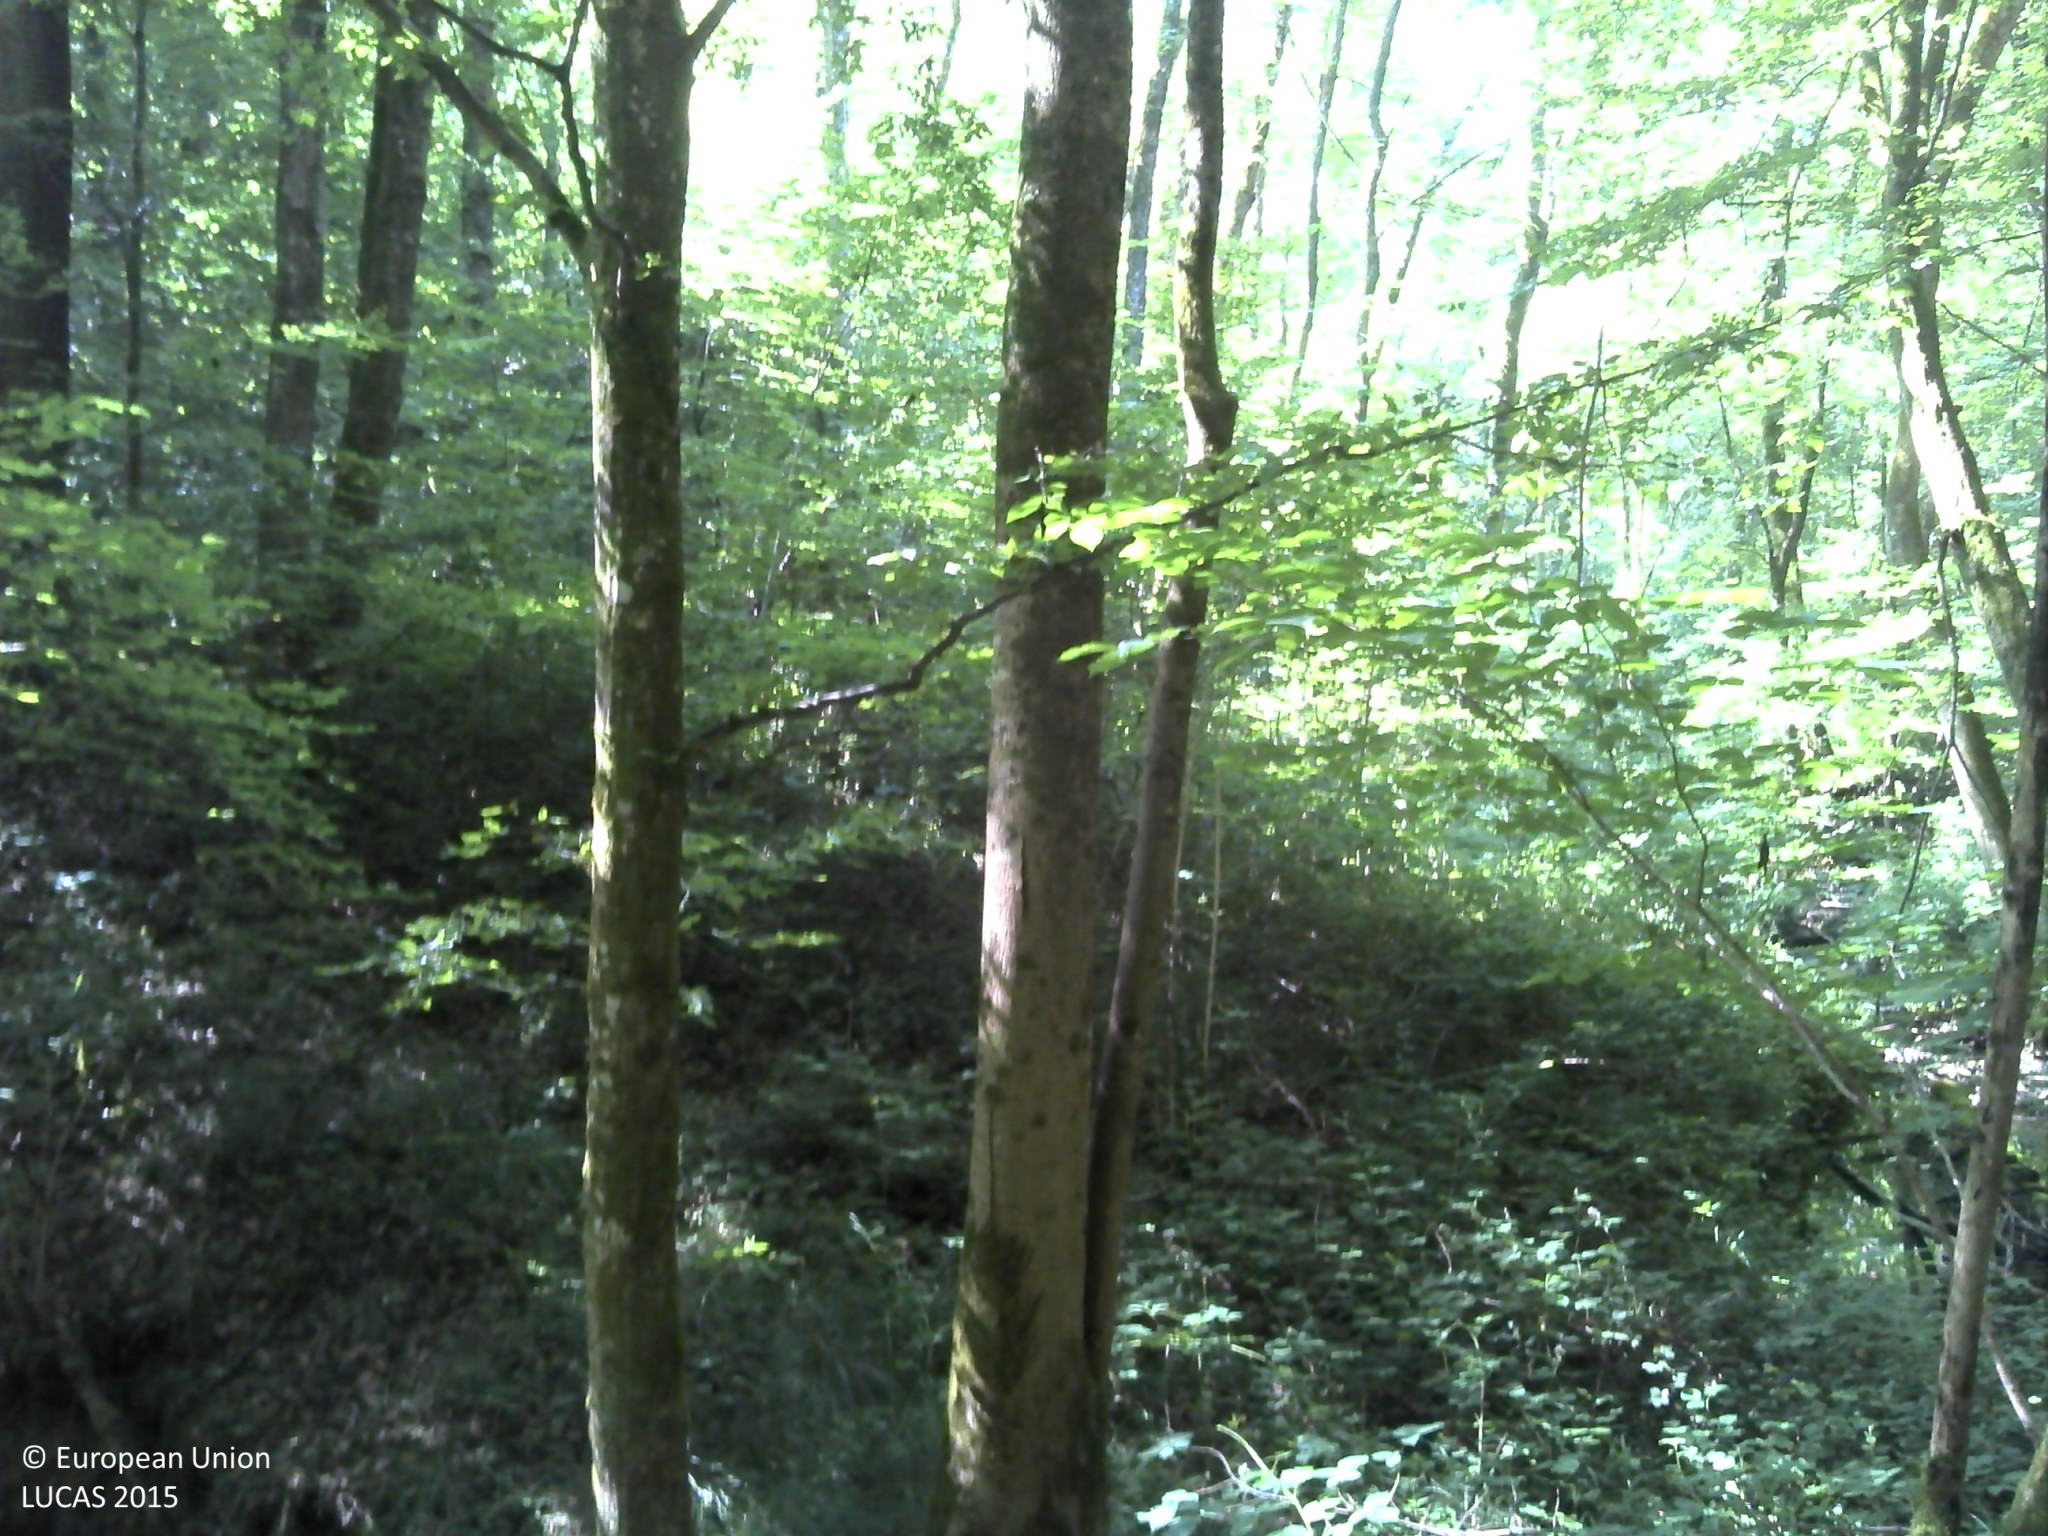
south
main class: Woodland
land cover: Broadleaved woodland
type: beech forest
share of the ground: > 75 %
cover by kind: broadleaved forest trees 70 %, herbaceous plants 20 %, lichens and mosses 5 %, consolidated bare surface 5 %
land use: Forestry
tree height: < 5 m
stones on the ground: < 10 %
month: July
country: FR
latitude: 49.6077
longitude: 4.6411
